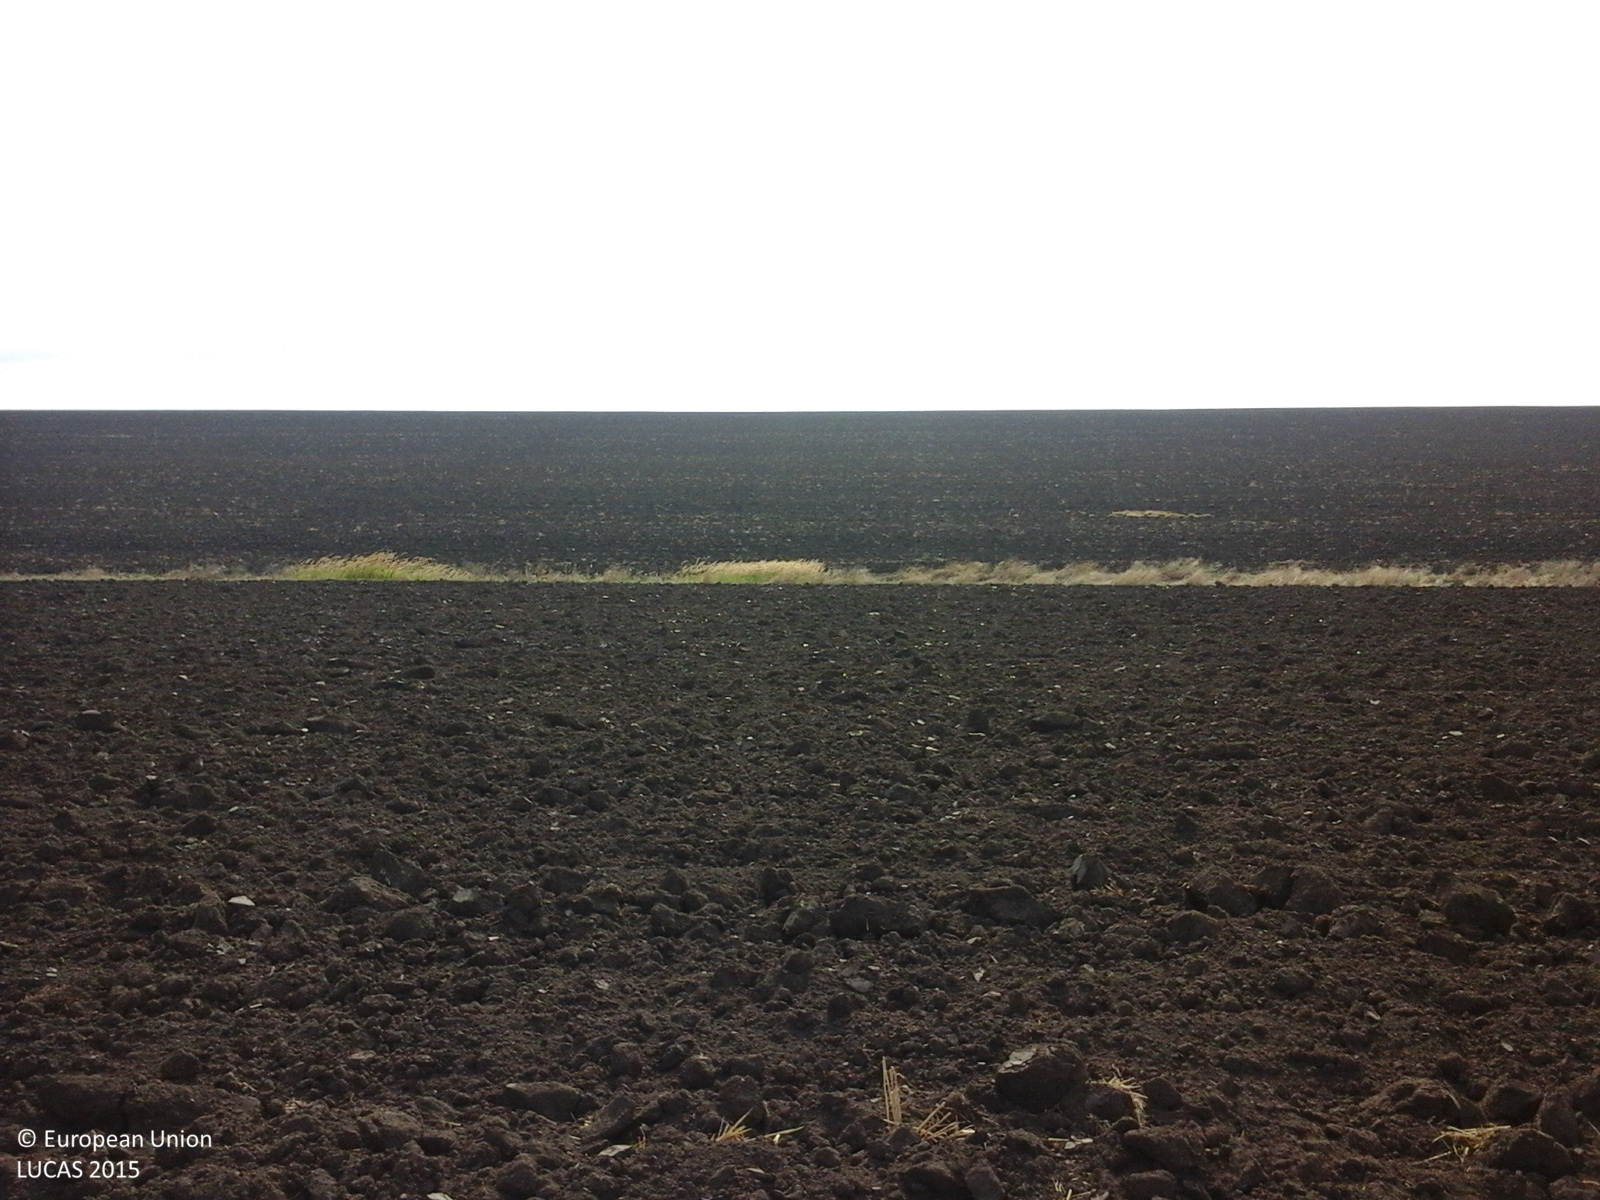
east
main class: Cropland
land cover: Common wheat
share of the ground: < 10 %
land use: Agriculture (excluding fallow land and kitchen gardens)
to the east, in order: Common wheat
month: August
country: RO
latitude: 45.1014
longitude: 28.8352
